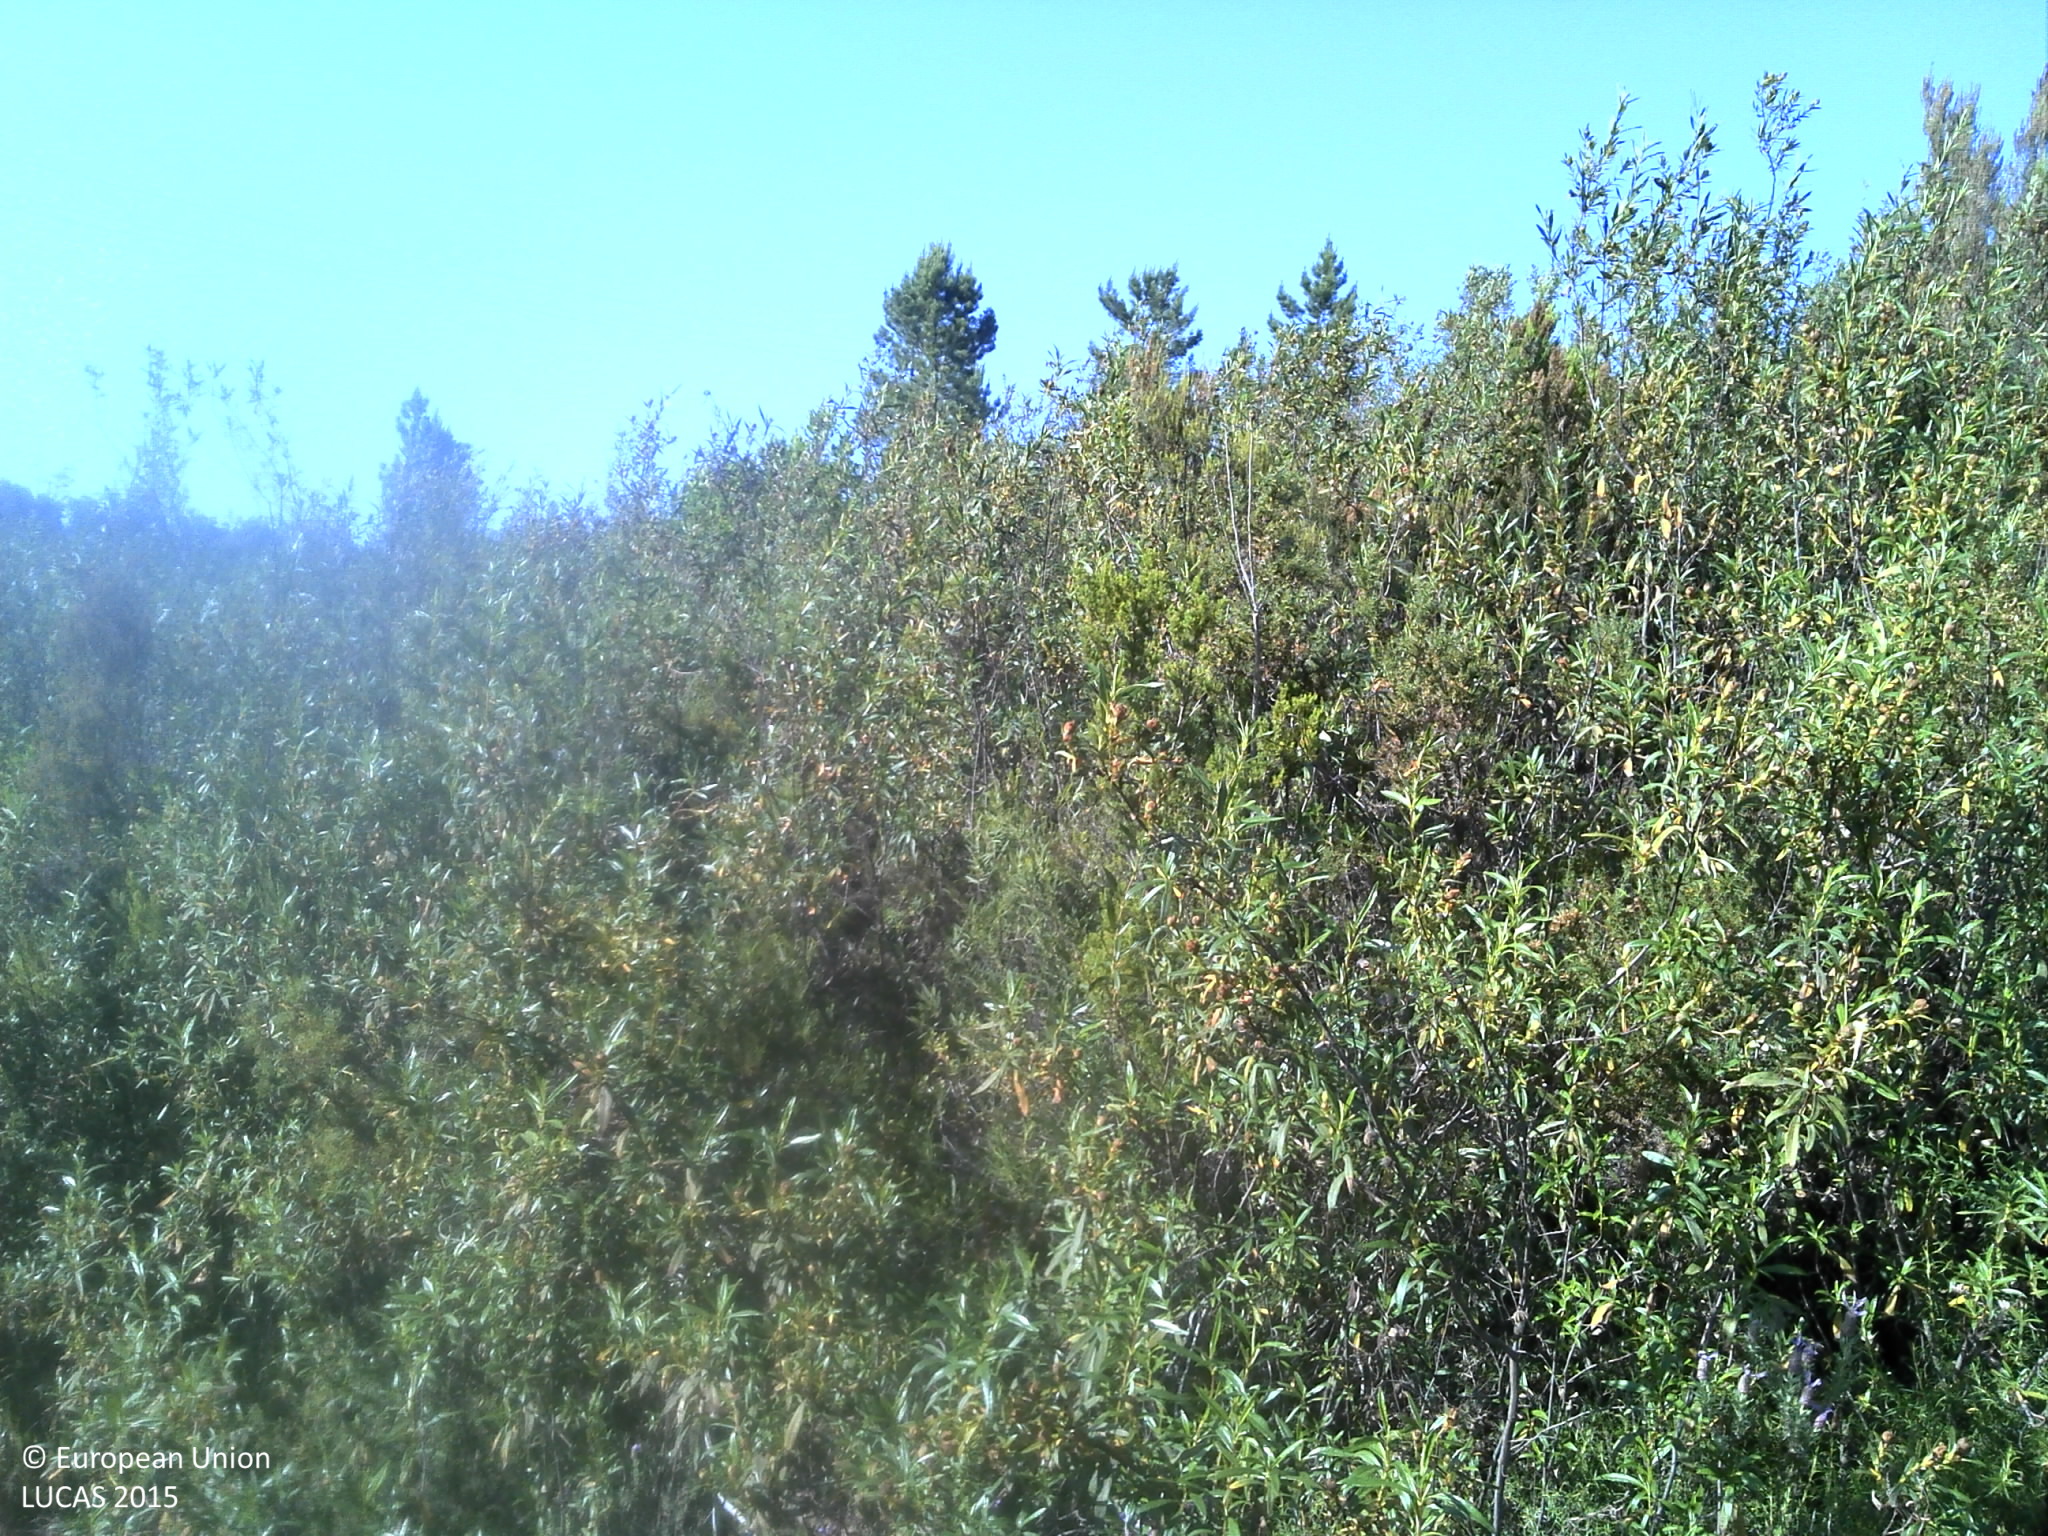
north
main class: Shrubland
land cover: Shrubland without tree cover
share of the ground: > 75 %
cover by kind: shrubs 85 %, herbaceous plants 10 %, unconsolidated bare surface 5 %
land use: Abandoned areas
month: May
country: PT
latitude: 39.5200
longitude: -8.3429
